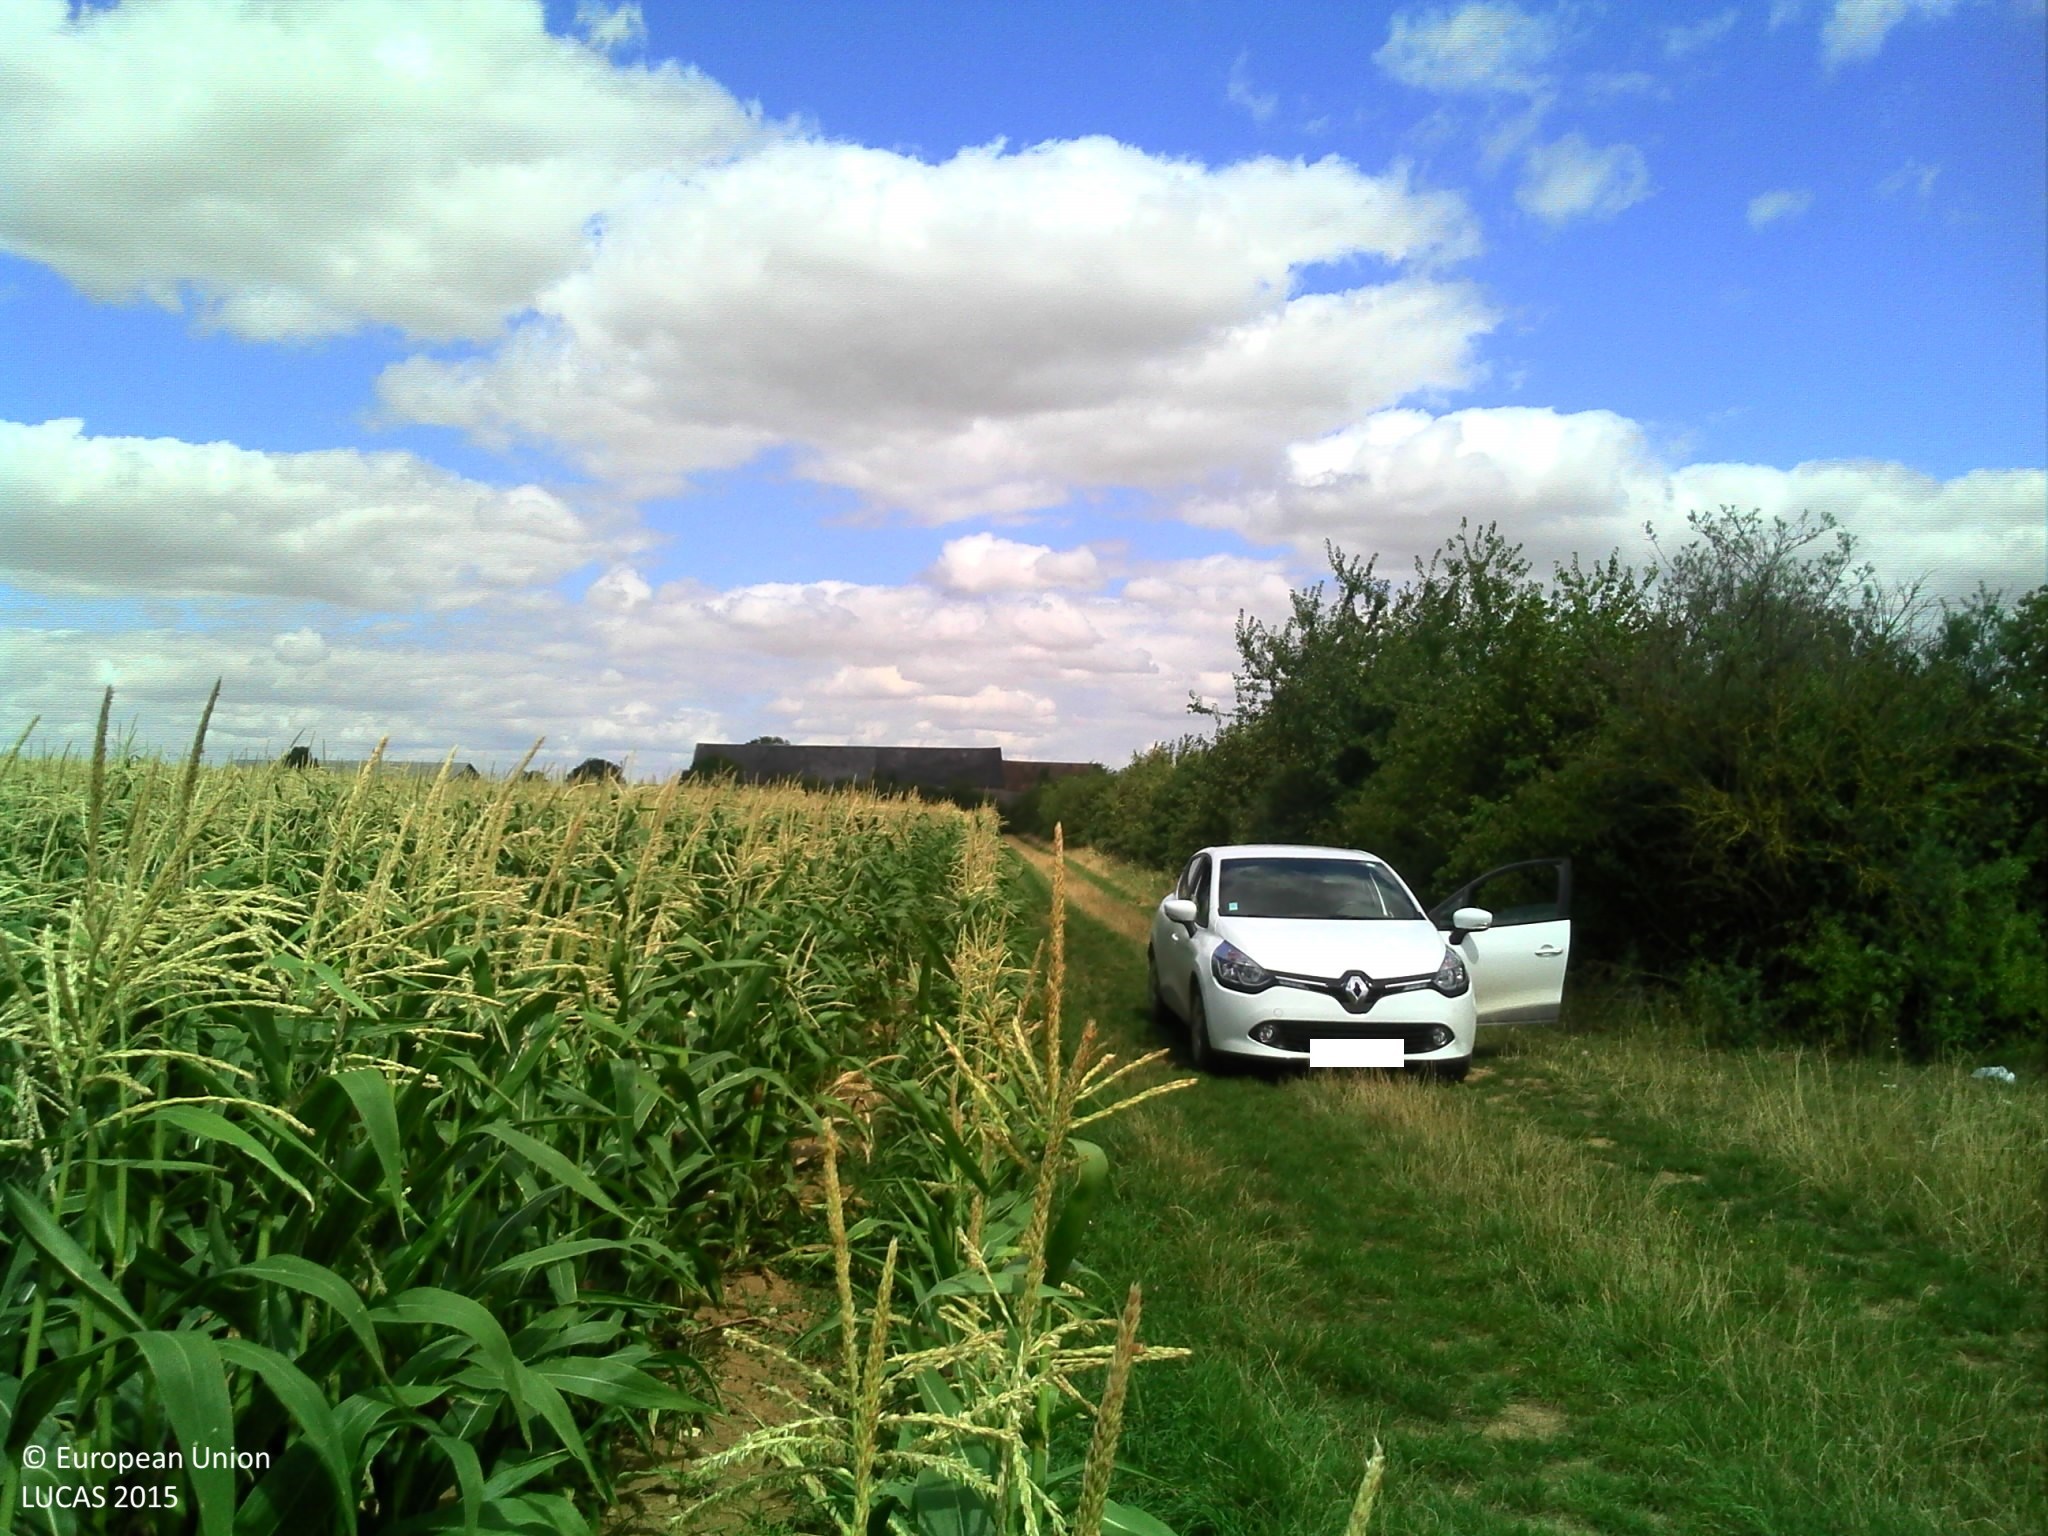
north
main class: Cropland
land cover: Maize
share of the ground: > 75 %
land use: Agriculture (excluding fallow land and kitchen gardens)
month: August
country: FR
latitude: 48.2202
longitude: 1.9784
